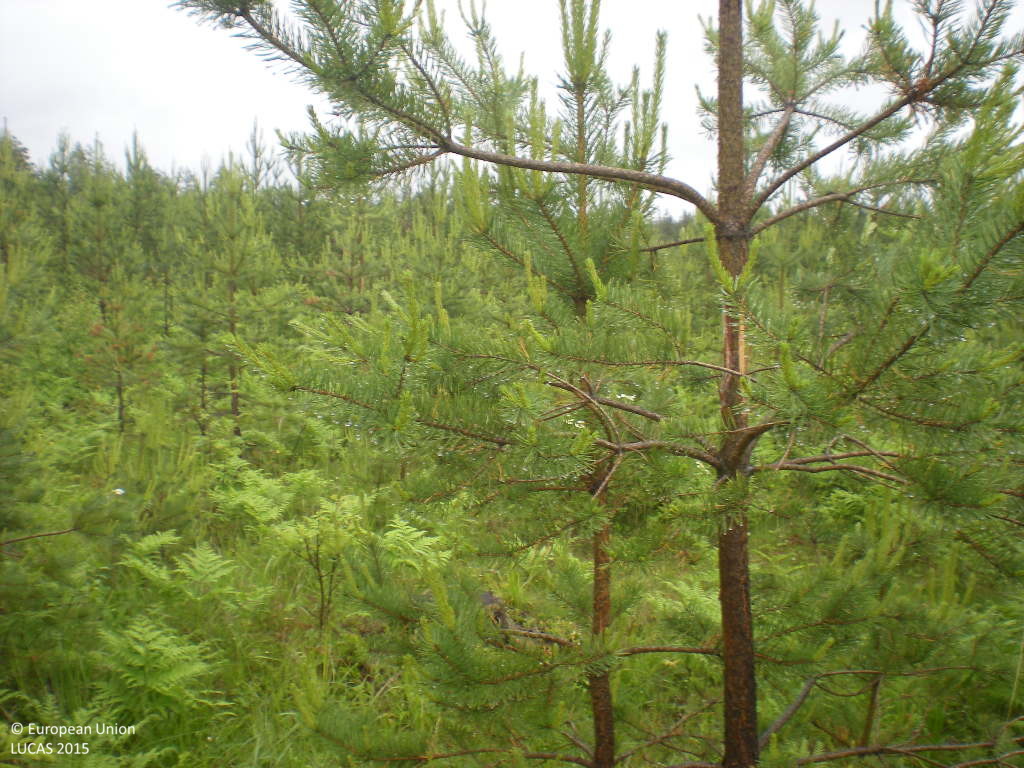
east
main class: Woodland
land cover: Other coniferous woodland
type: boreal forest
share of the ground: 25 - 50 %
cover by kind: coniferous forest trees 50 %, herbaceous plants 30 %, shrubs 10 %, lichens and mosses 5 %, consolidated bare surface 5 %
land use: Forestry
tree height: < 5 m
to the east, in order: Other coniferous woodland; Pine dominated coniferous woodland; Tracks; Pine dominated coniferous woodland; Other coniferous woodland; Other mixed woodland; Shrubland with sparse tree cover; Other coniferous woodland
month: June
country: SE
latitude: 60.3943
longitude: 17.8865
